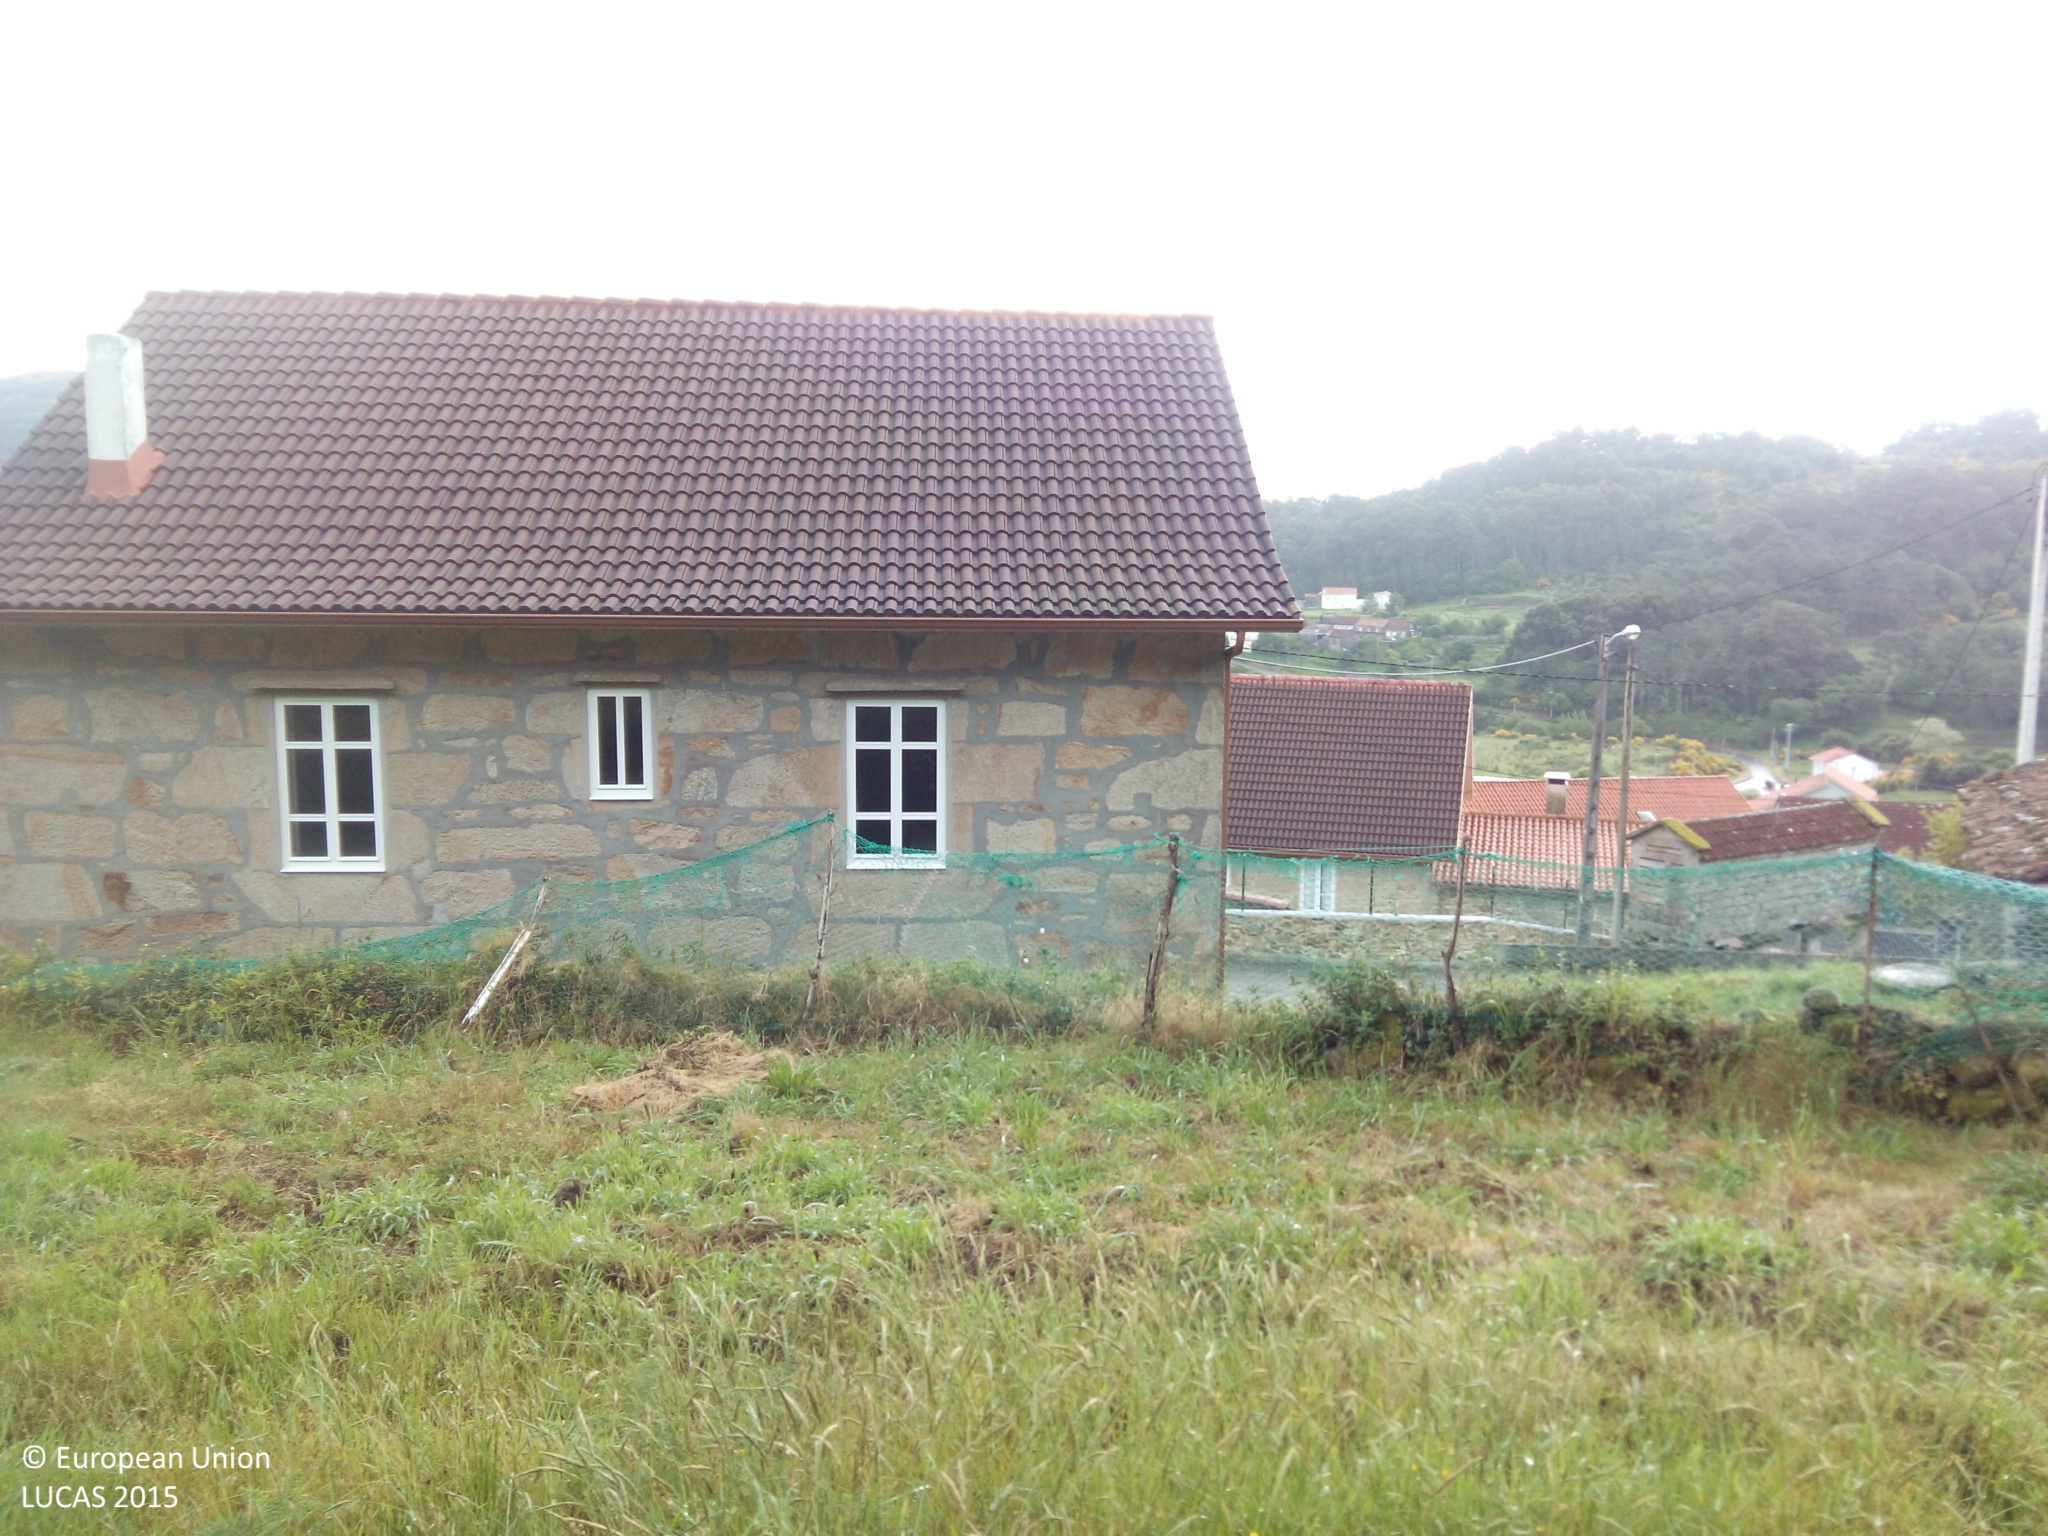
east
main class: Woodland
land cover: Pine dominated mixed woodland
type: exotic forest
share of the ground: 10 - 25 %
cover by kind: herbaceous plants 75 %, coniferous forest trees 15 %, broadleaved forest trees 10 %
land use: Forestry
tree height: > 5 m
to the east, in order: Pine dominated mixed woodland; Spontaneously vegetated surfaces; Shruby margins; Artificial constructions in urban areas; Broadleaved woodland; Grassland without tree/shrub cover; Shrubland without tree cover; Ditches and canals; Shrubland without tree cover; Spontaneously vegetated surfaces
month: May
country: ES
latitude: 42.7817
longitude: -9.0795
